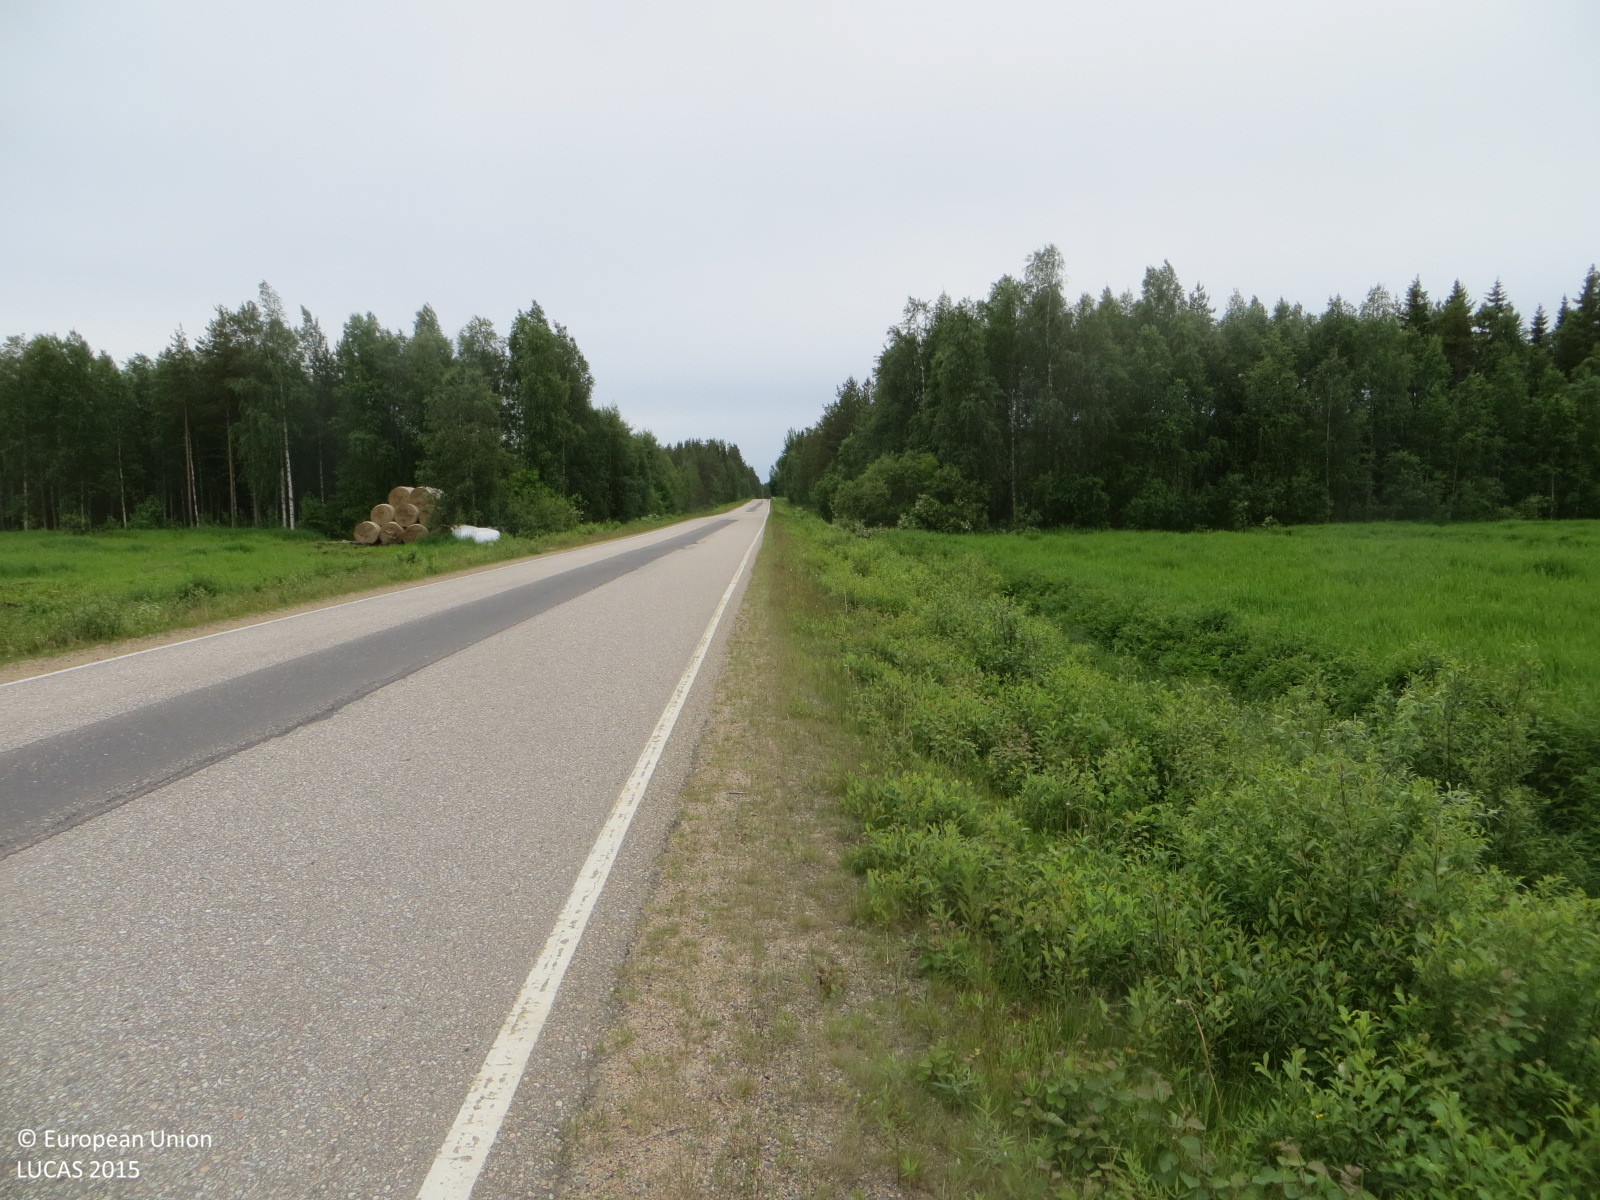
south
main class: Cropland
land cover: Permanent industrial crops
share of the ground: > 75 %
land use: Agriculture (excluding fallow land and kitchen gardens)
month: July
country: FI
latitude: 65.5251
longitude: 25.9878
